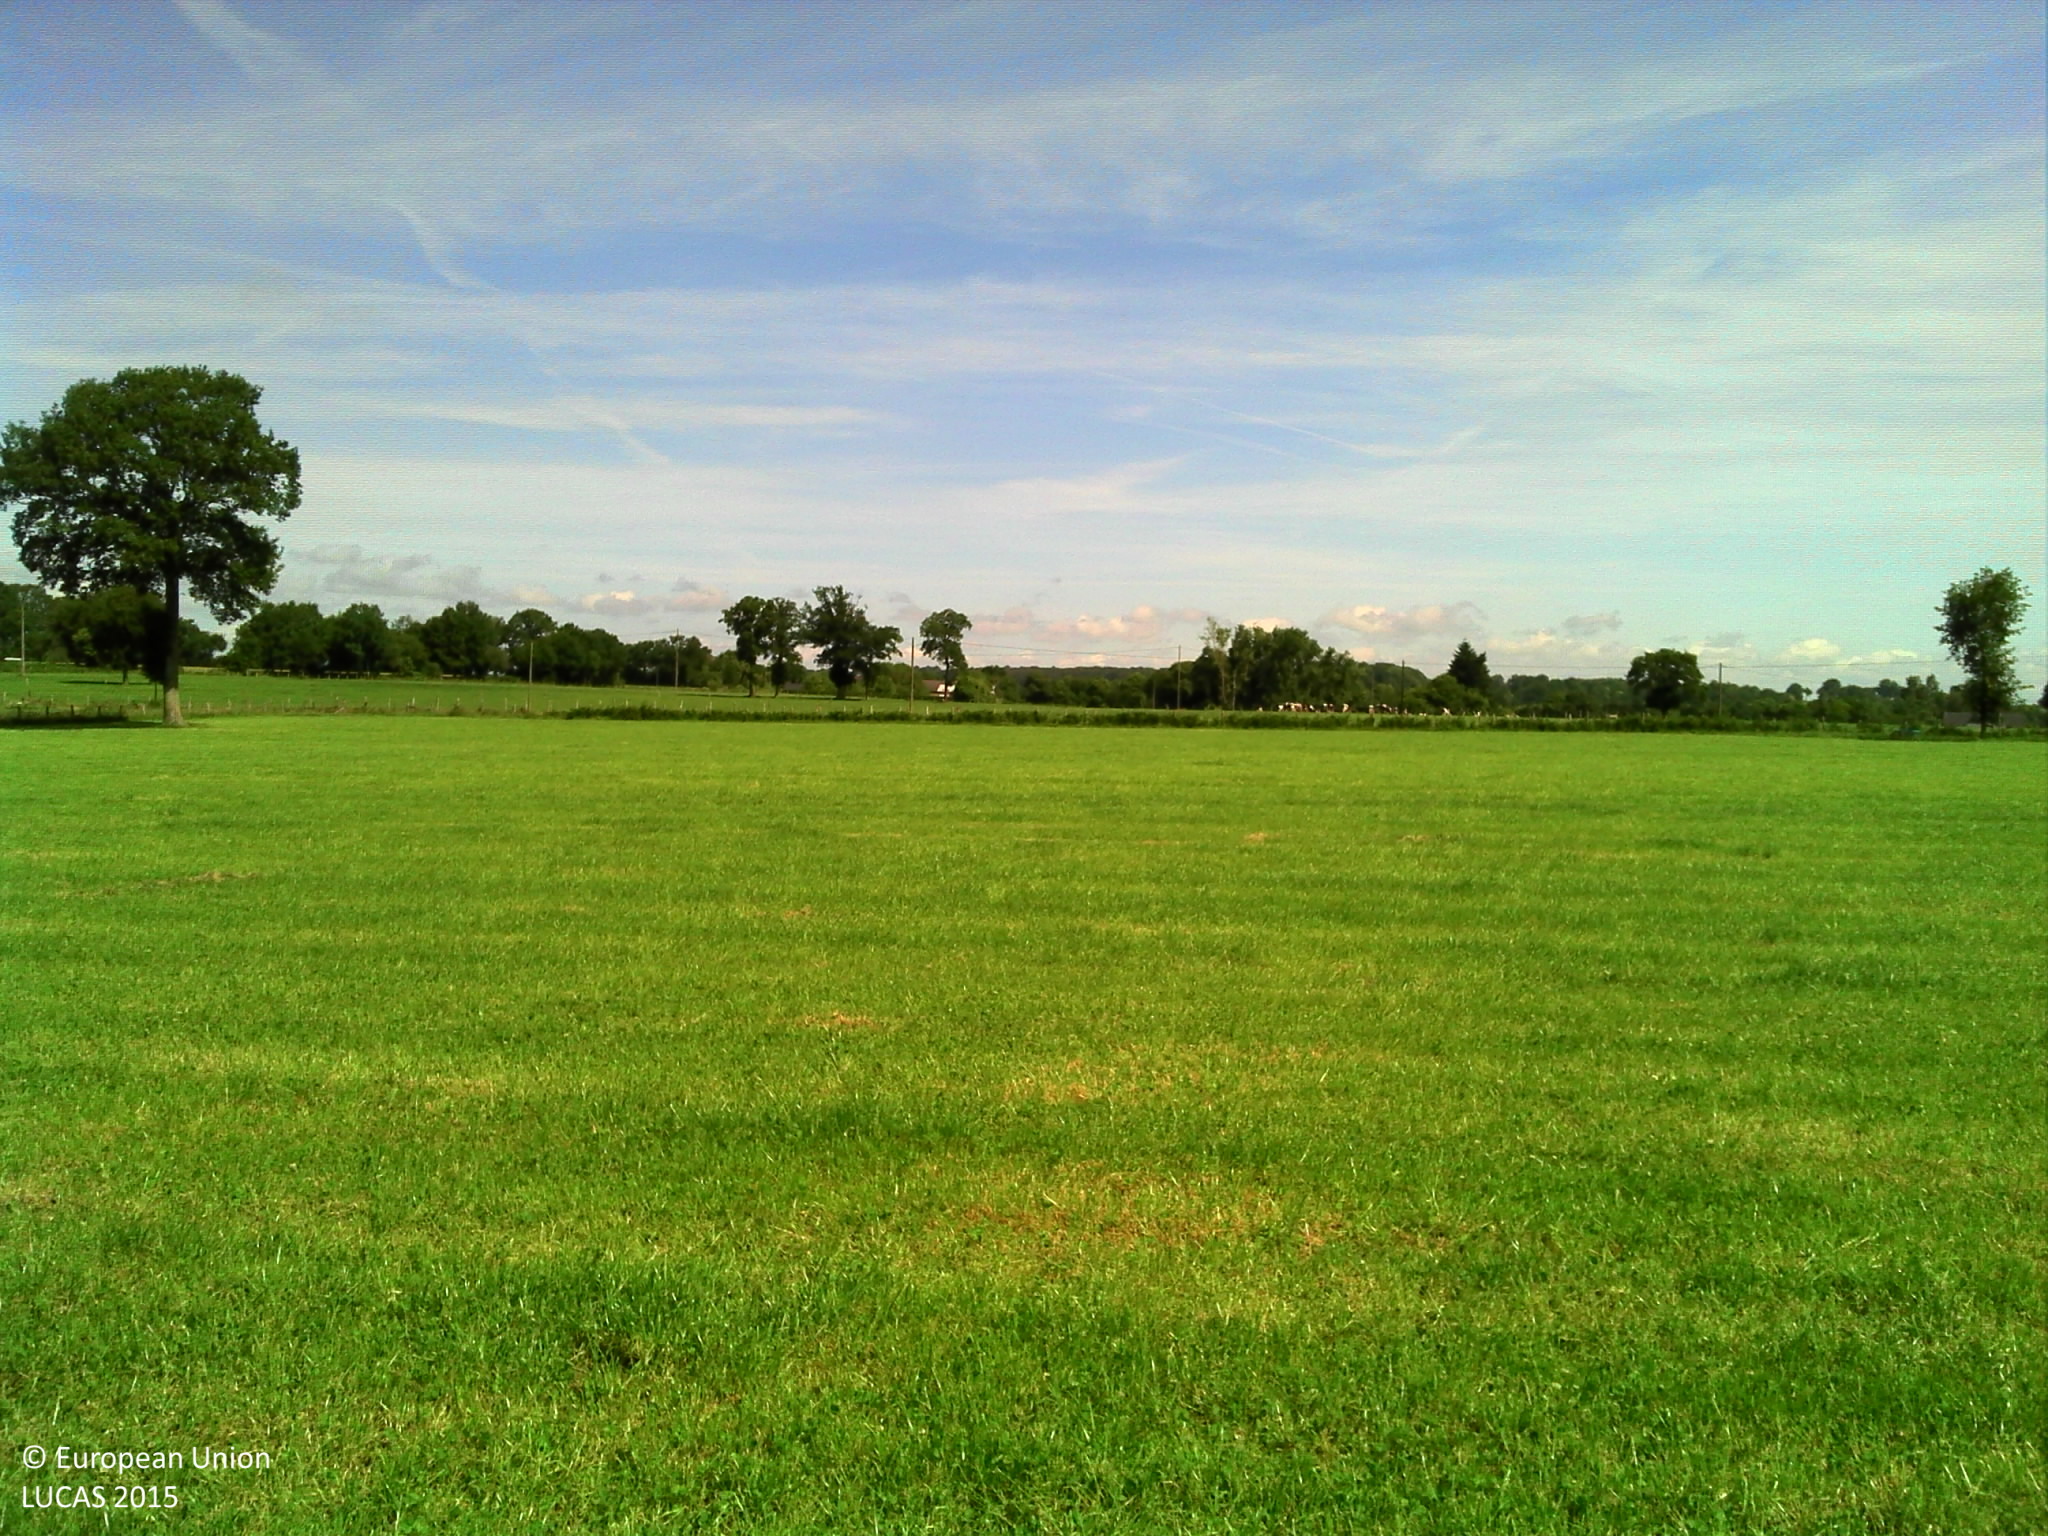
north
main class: Cropland
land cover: Temporary grasslands
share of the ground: > 75 %
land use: Agriculture (excluding fallow land and kitchen gardens)
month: June
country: FR
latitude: 48.3135
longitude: -1.4672
